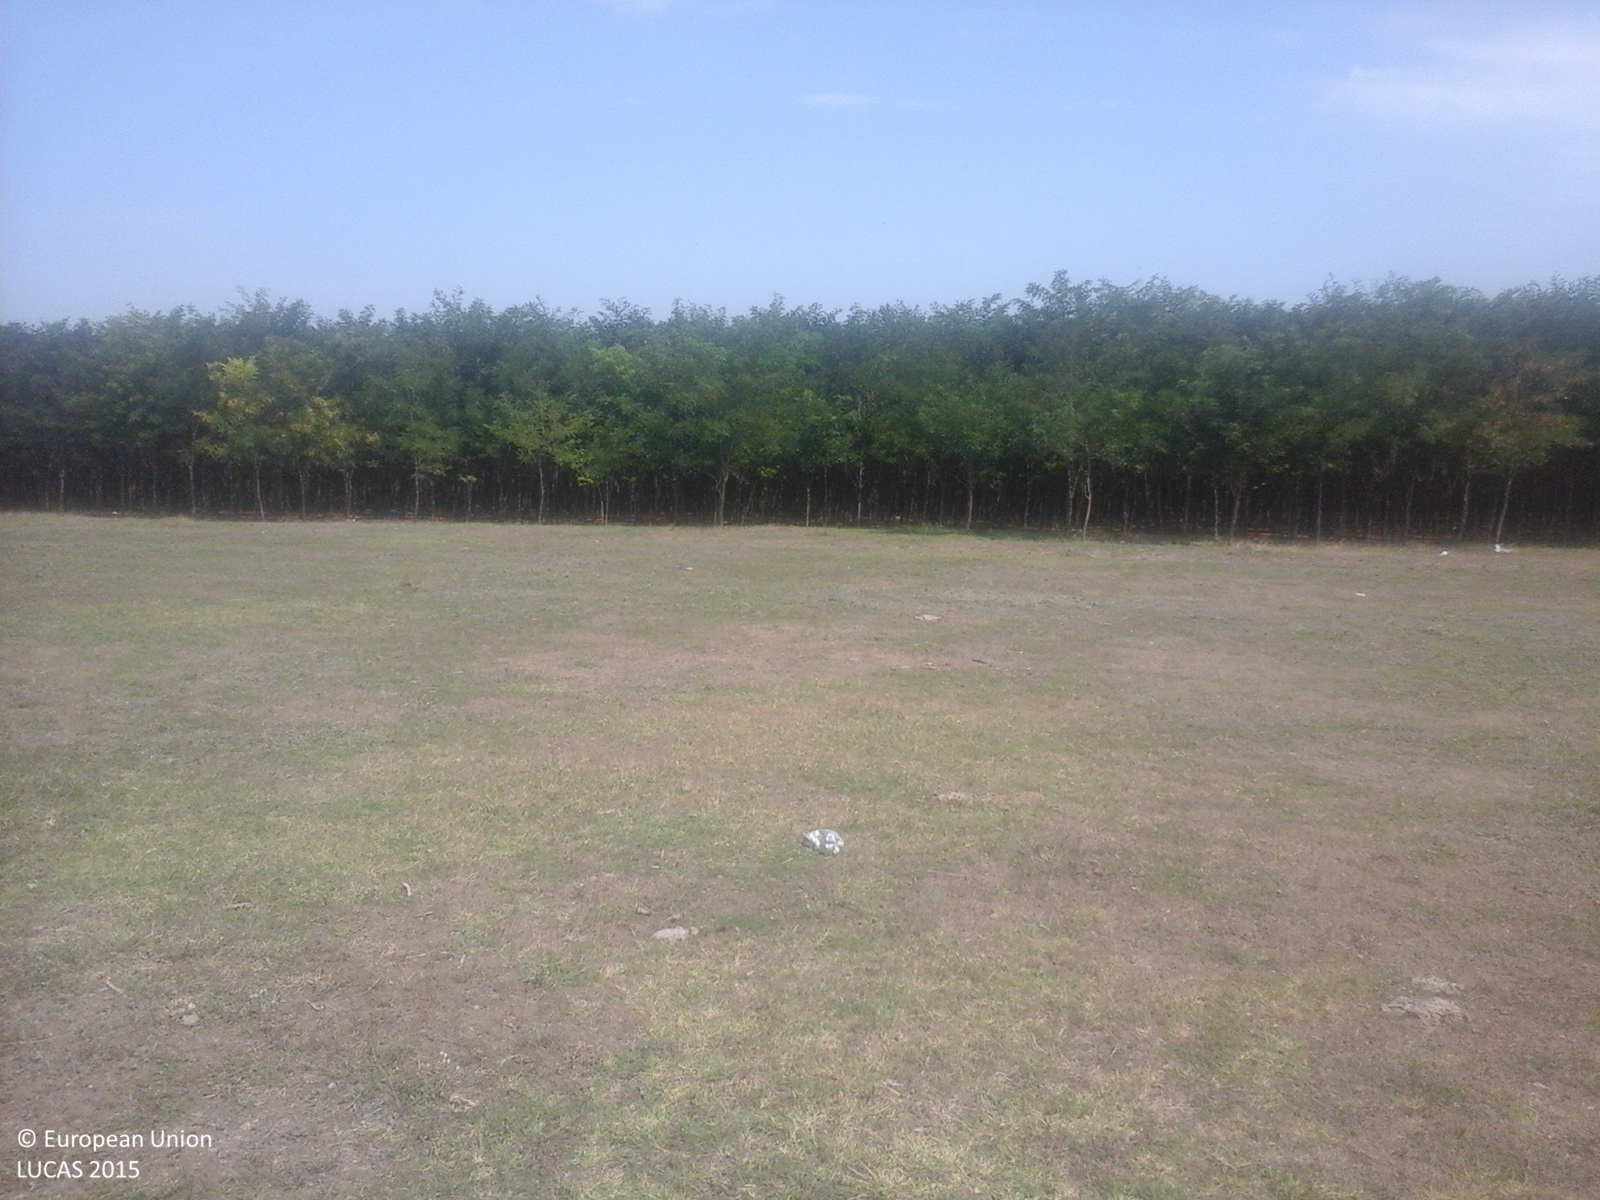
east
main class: Grassland
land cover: Grassland without tree/shrub cover
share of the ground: > 75 %
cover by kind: herbaceous plants 100 %
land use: Agriculture (excluding fallow land and kitchen gardens)
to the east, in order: Grassland without tree/shrub cover; Tracks; Grassland without tree/shrub cover; Broadleaved woodland; Tracks; Maize; Lucerne; Maize; Common wheat
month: August
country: RO
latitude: 44.1104
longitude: 28.2912
